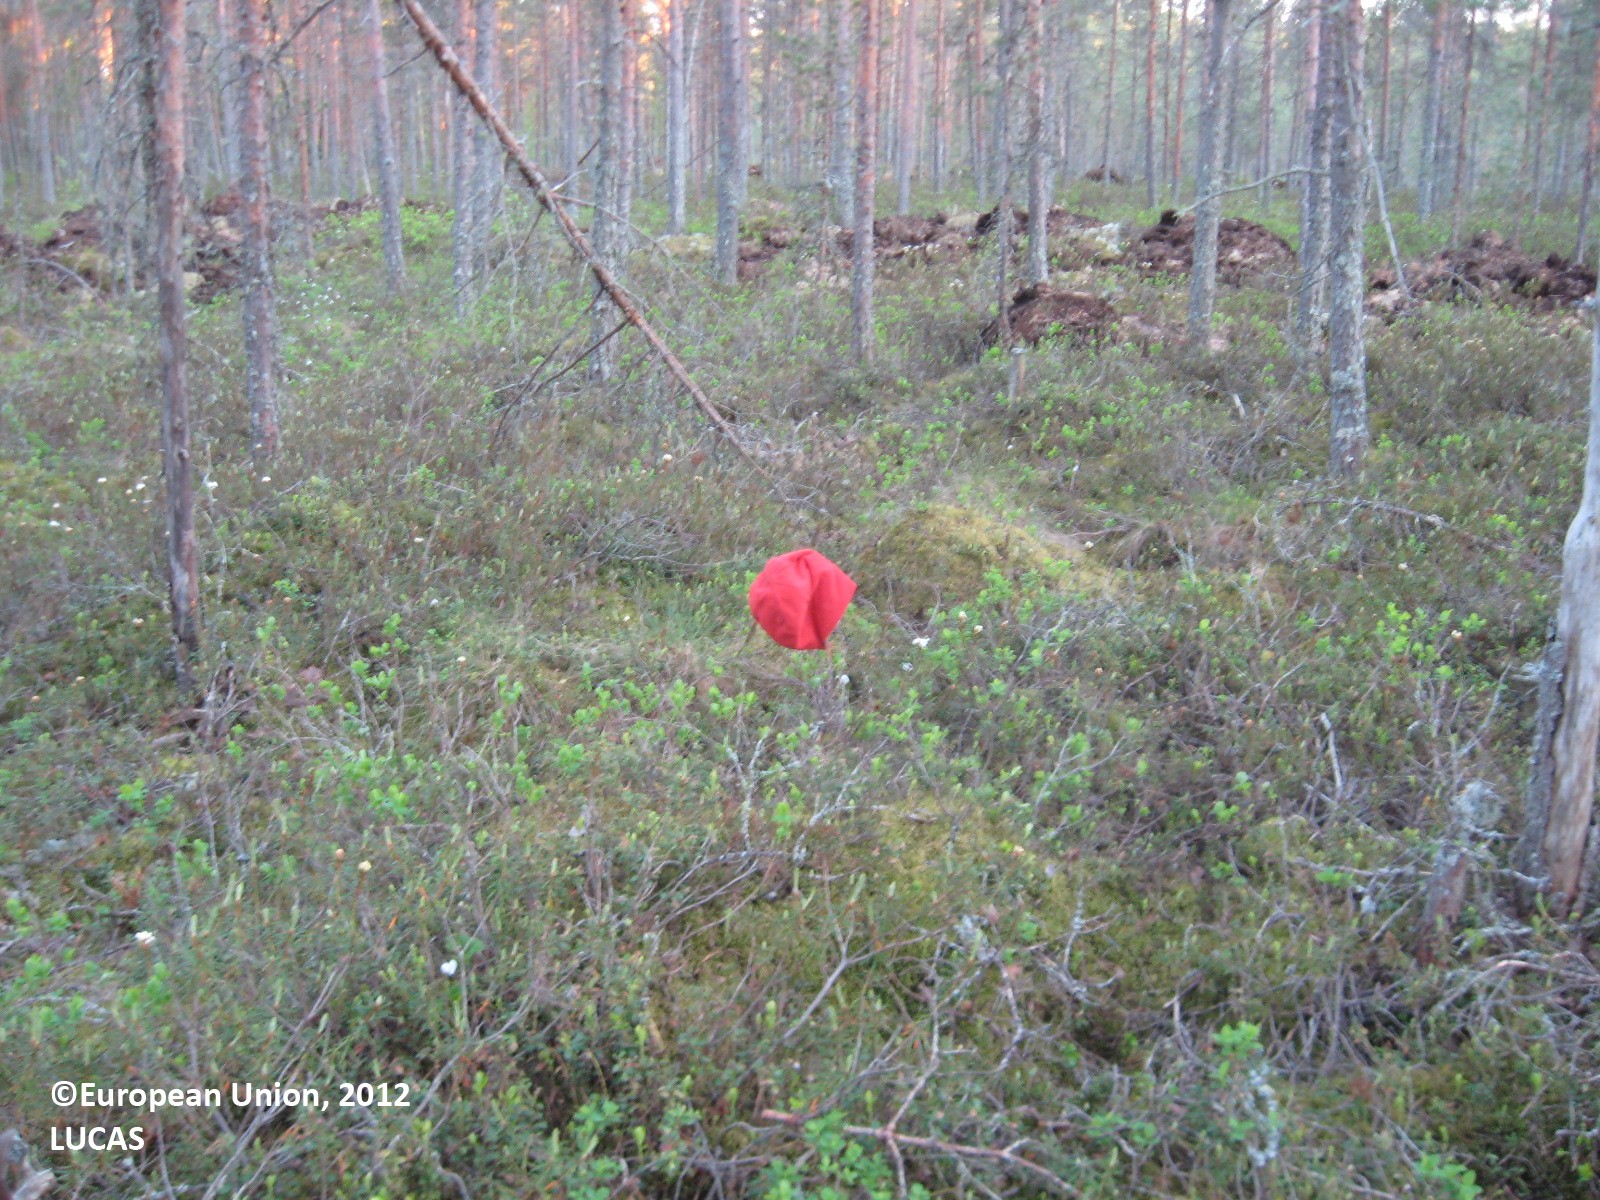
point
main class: Woodland
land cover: Pine dominated coniferous woodland
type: boreal forest
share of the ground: 50 - 75 %
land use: Forestry
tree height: > 5 m
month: June
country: FI
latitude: 63.2589
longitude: 22.7418
